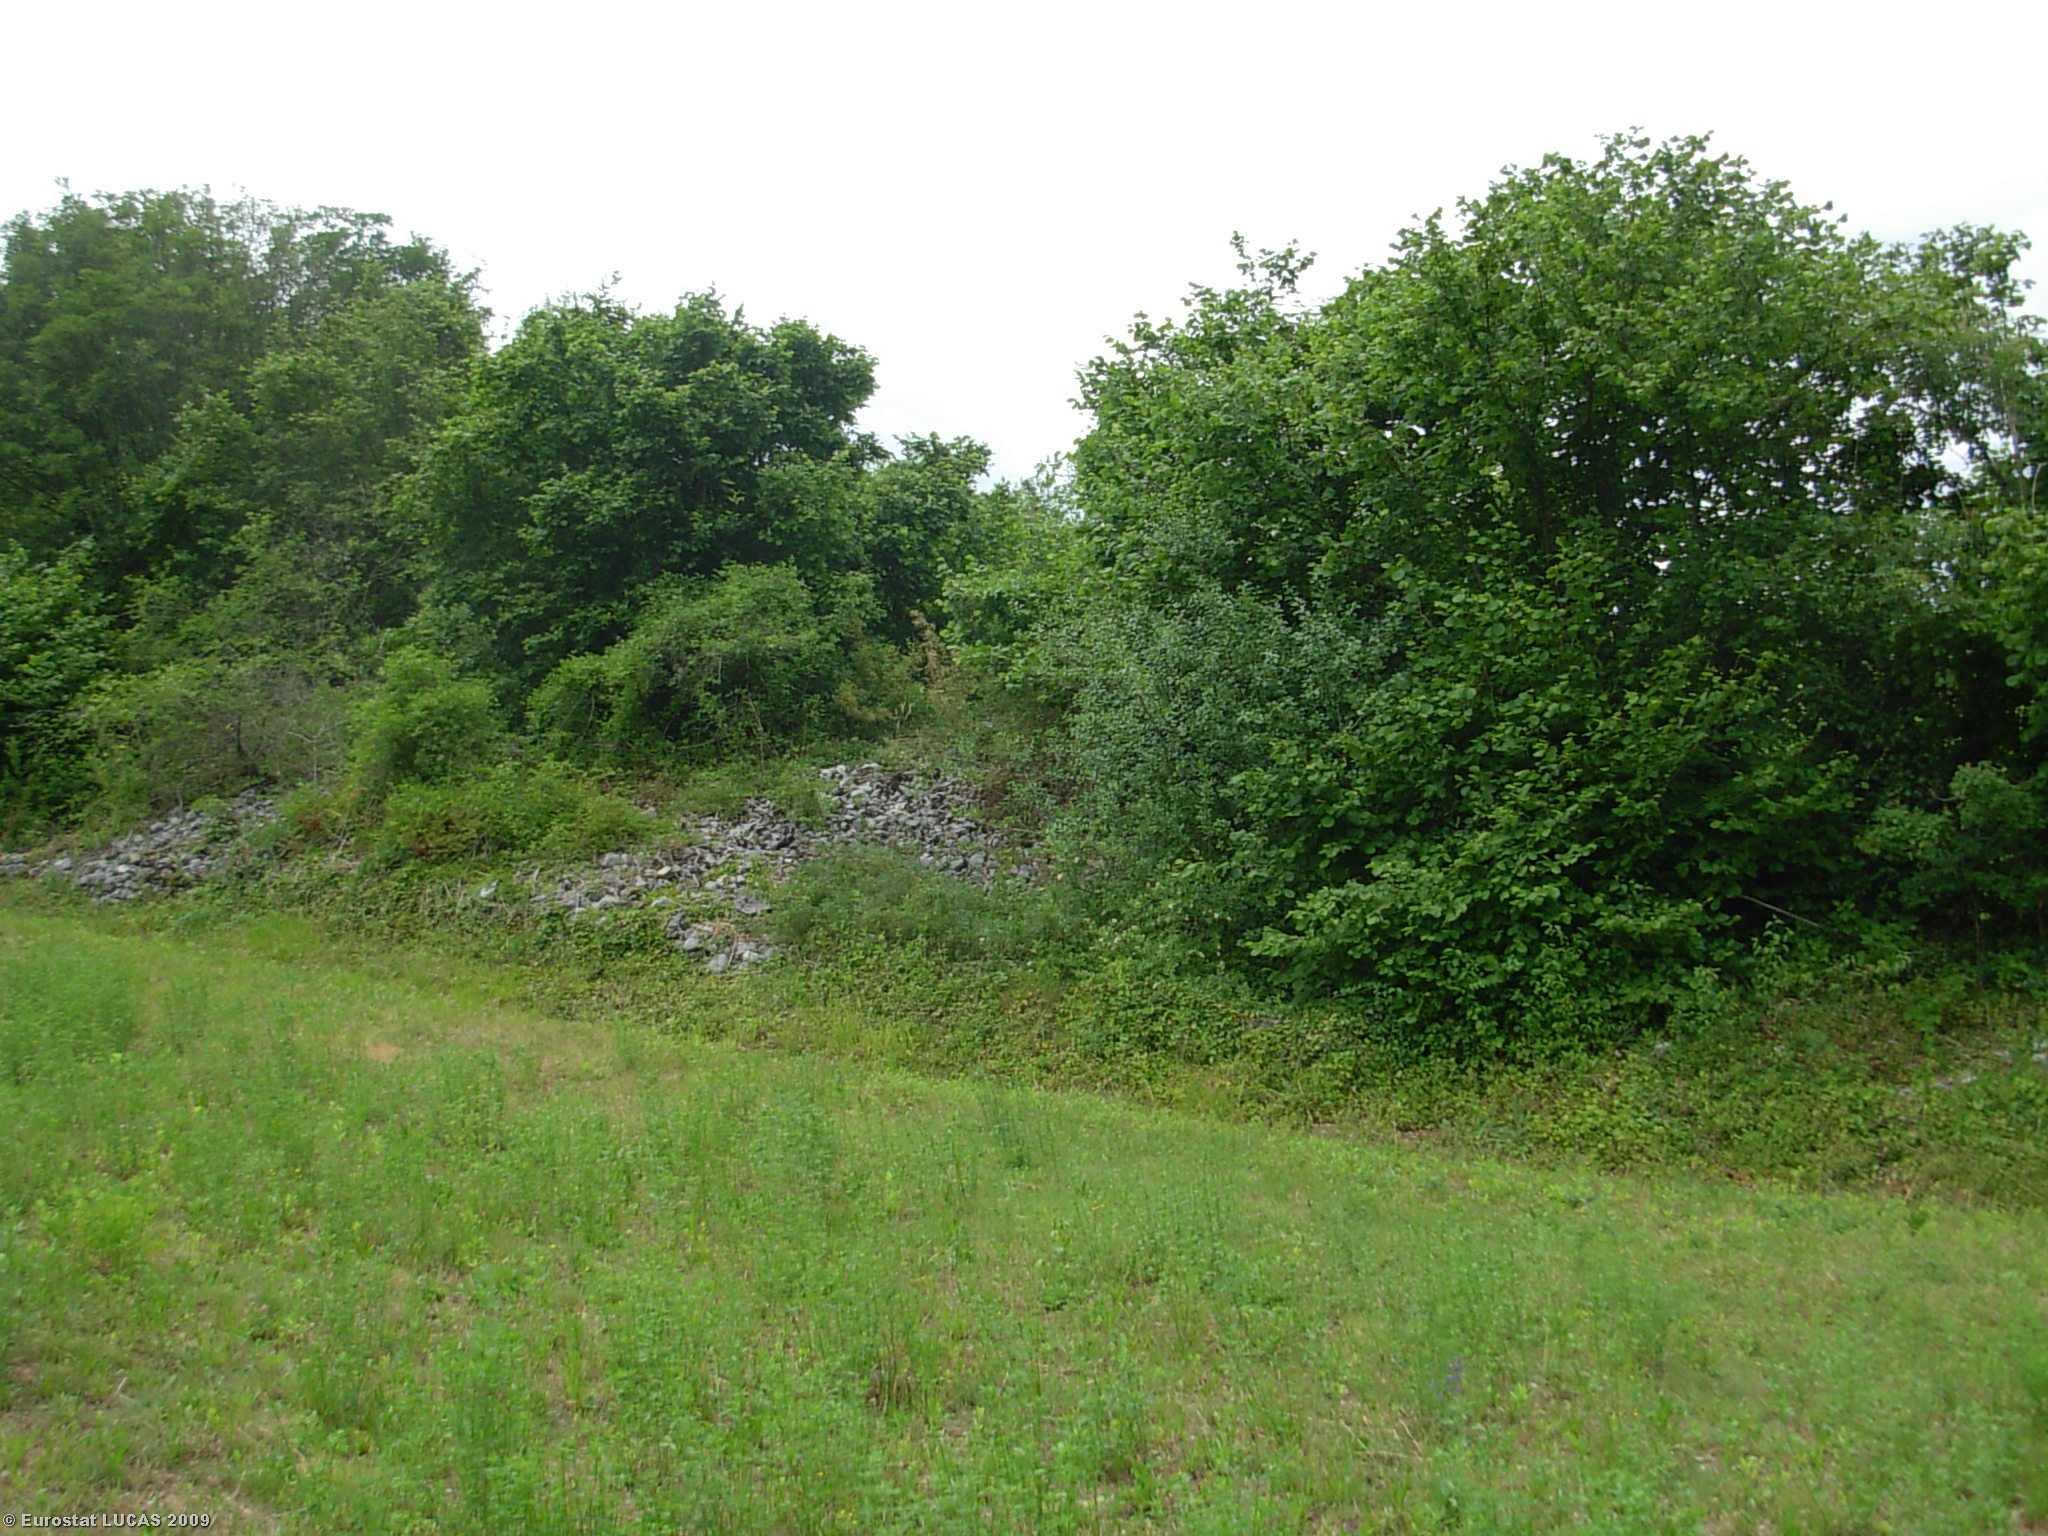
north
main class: Cropland
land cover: Lucerne
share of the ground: > 75 %
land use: Agriculture (excluding fallow land and kitchen gardens)
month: June
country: IT
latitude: 45.9904
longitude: 10.3223
